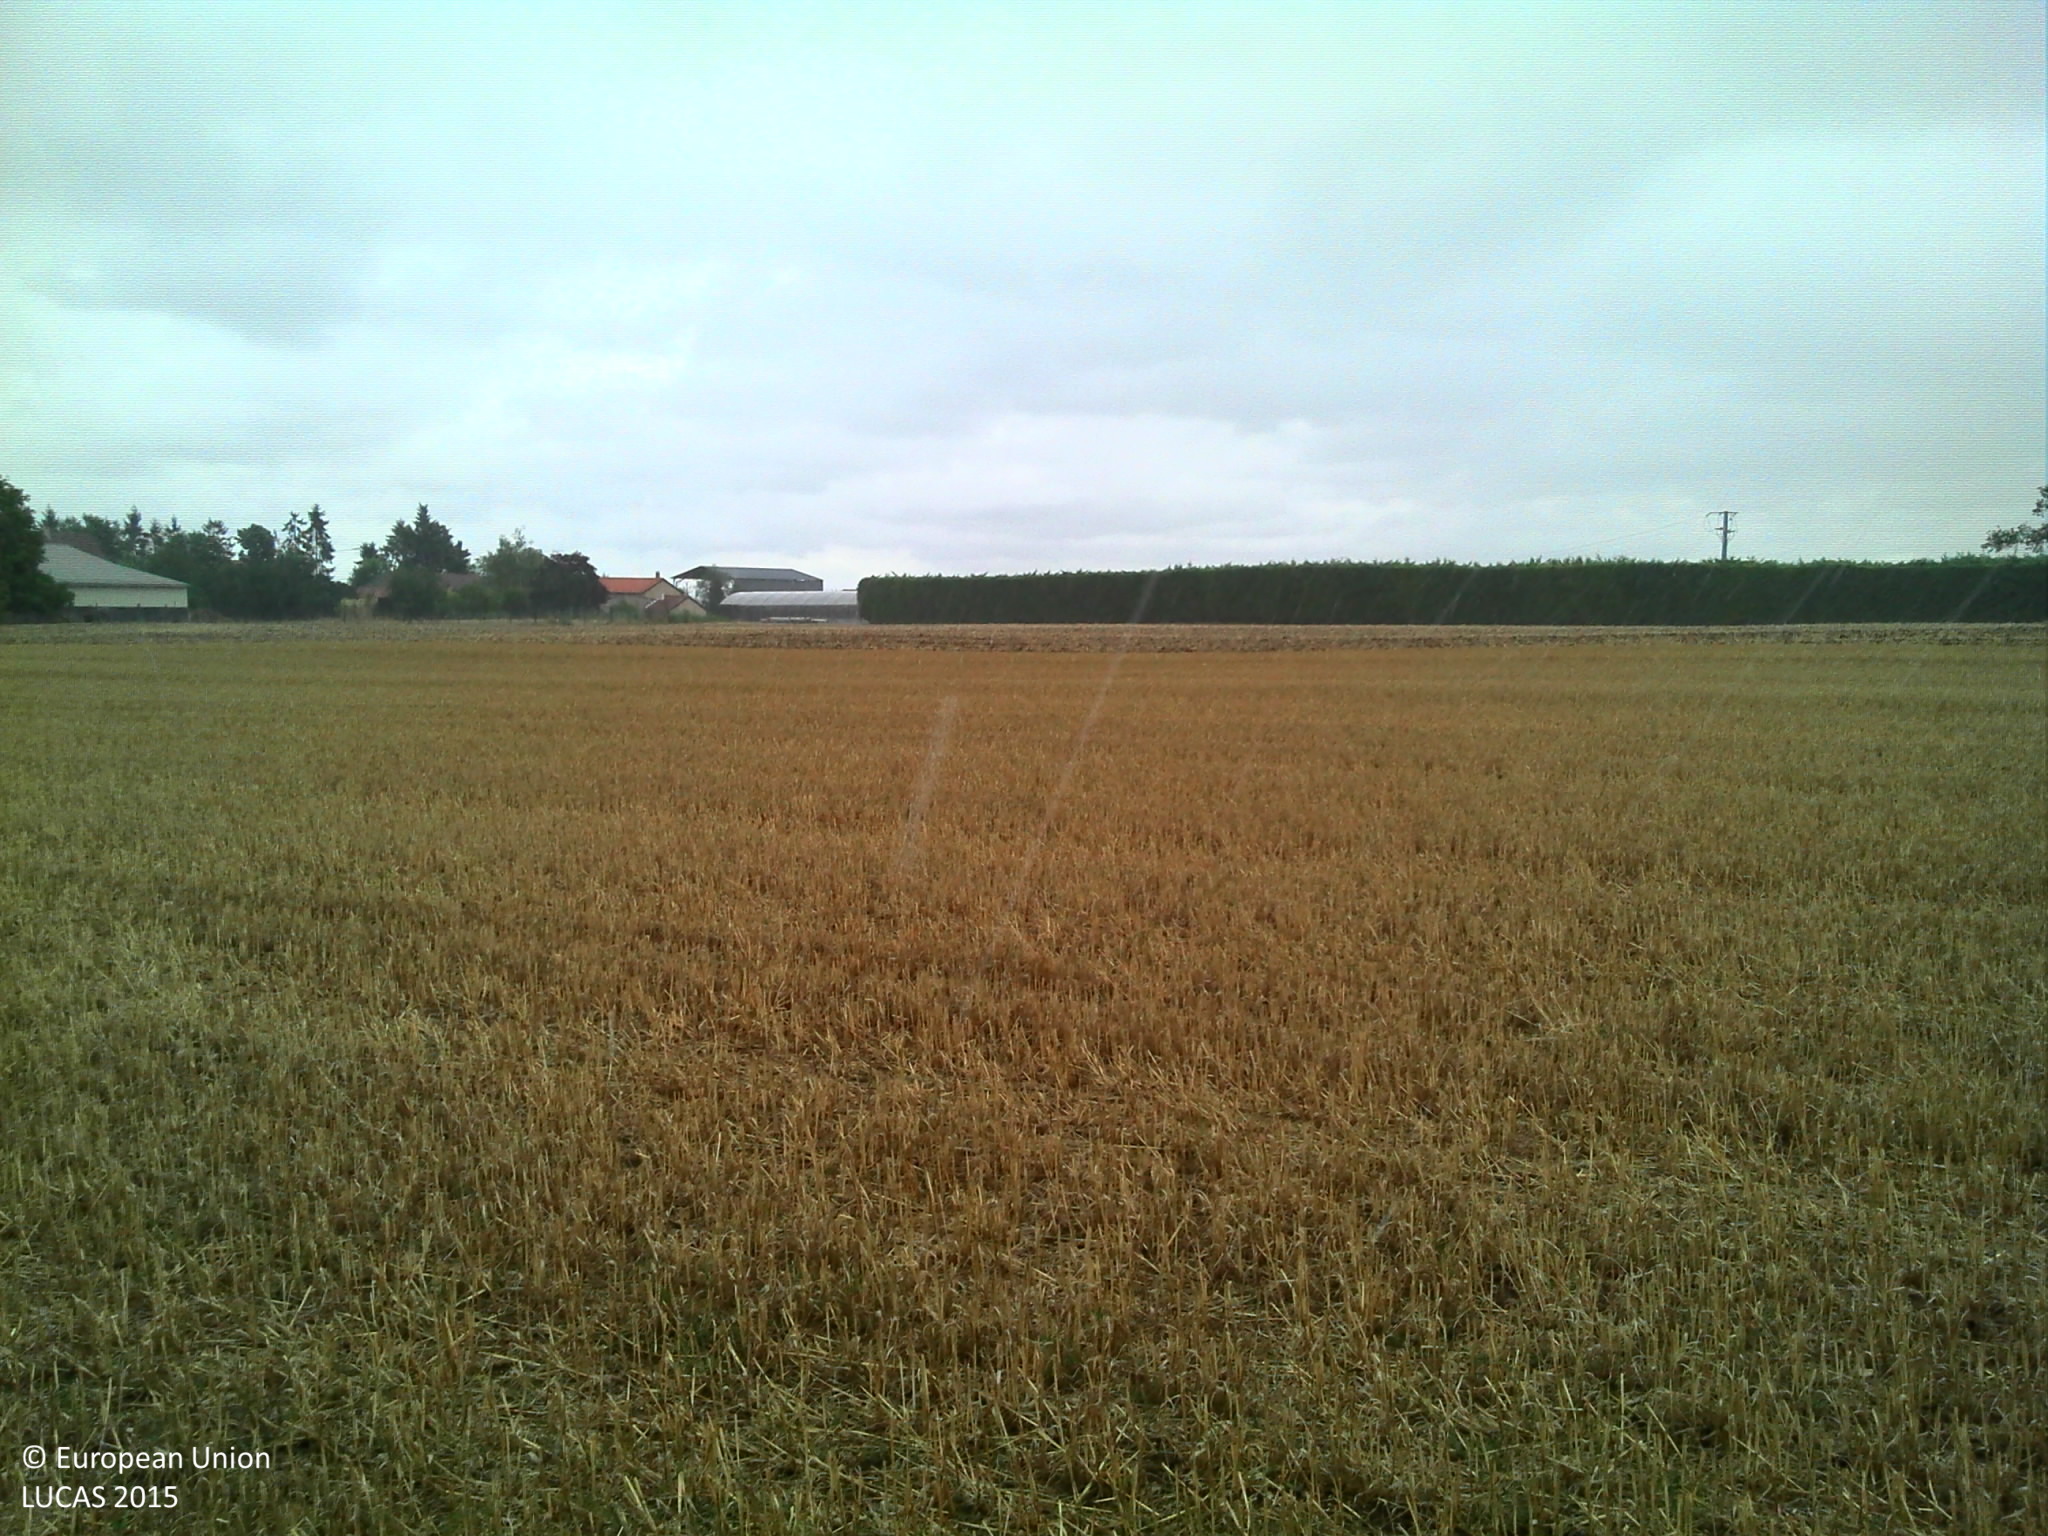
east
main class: Cropland
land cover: Common wheat
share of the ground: < 10 %
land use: Agriculture (excluding fallow land and kitchen gardens)
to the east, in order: Common wheat; Artificial constructions in urban areas; Sunflower; Artificial constructions in urban areas
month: August
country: FR
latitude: 46.7478
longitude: 0.1481
